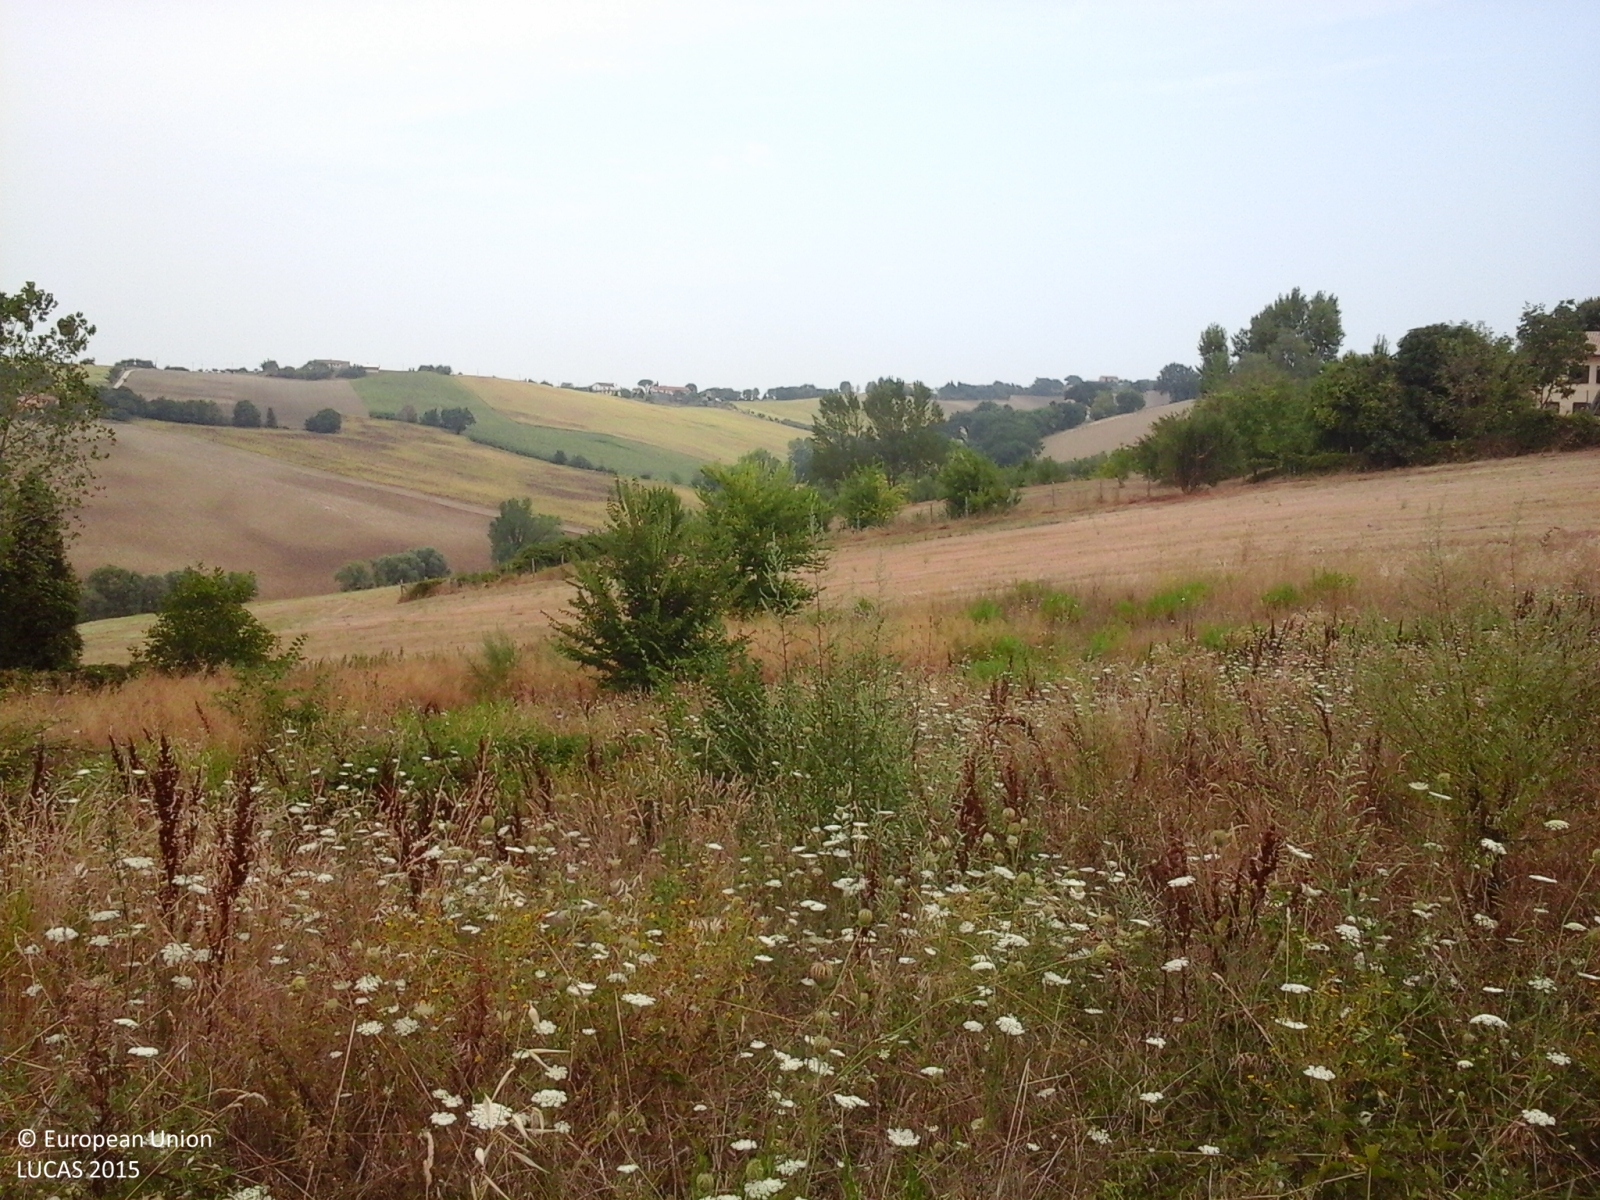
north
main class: Grassland
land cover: Spontaneously vegetated surfaces
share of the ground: > 75 %
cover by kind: herbaceous plants 95 %, shrubs 5 %
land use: Fallow land
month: August
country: IT
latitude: 43.4998
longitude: 13.4174
